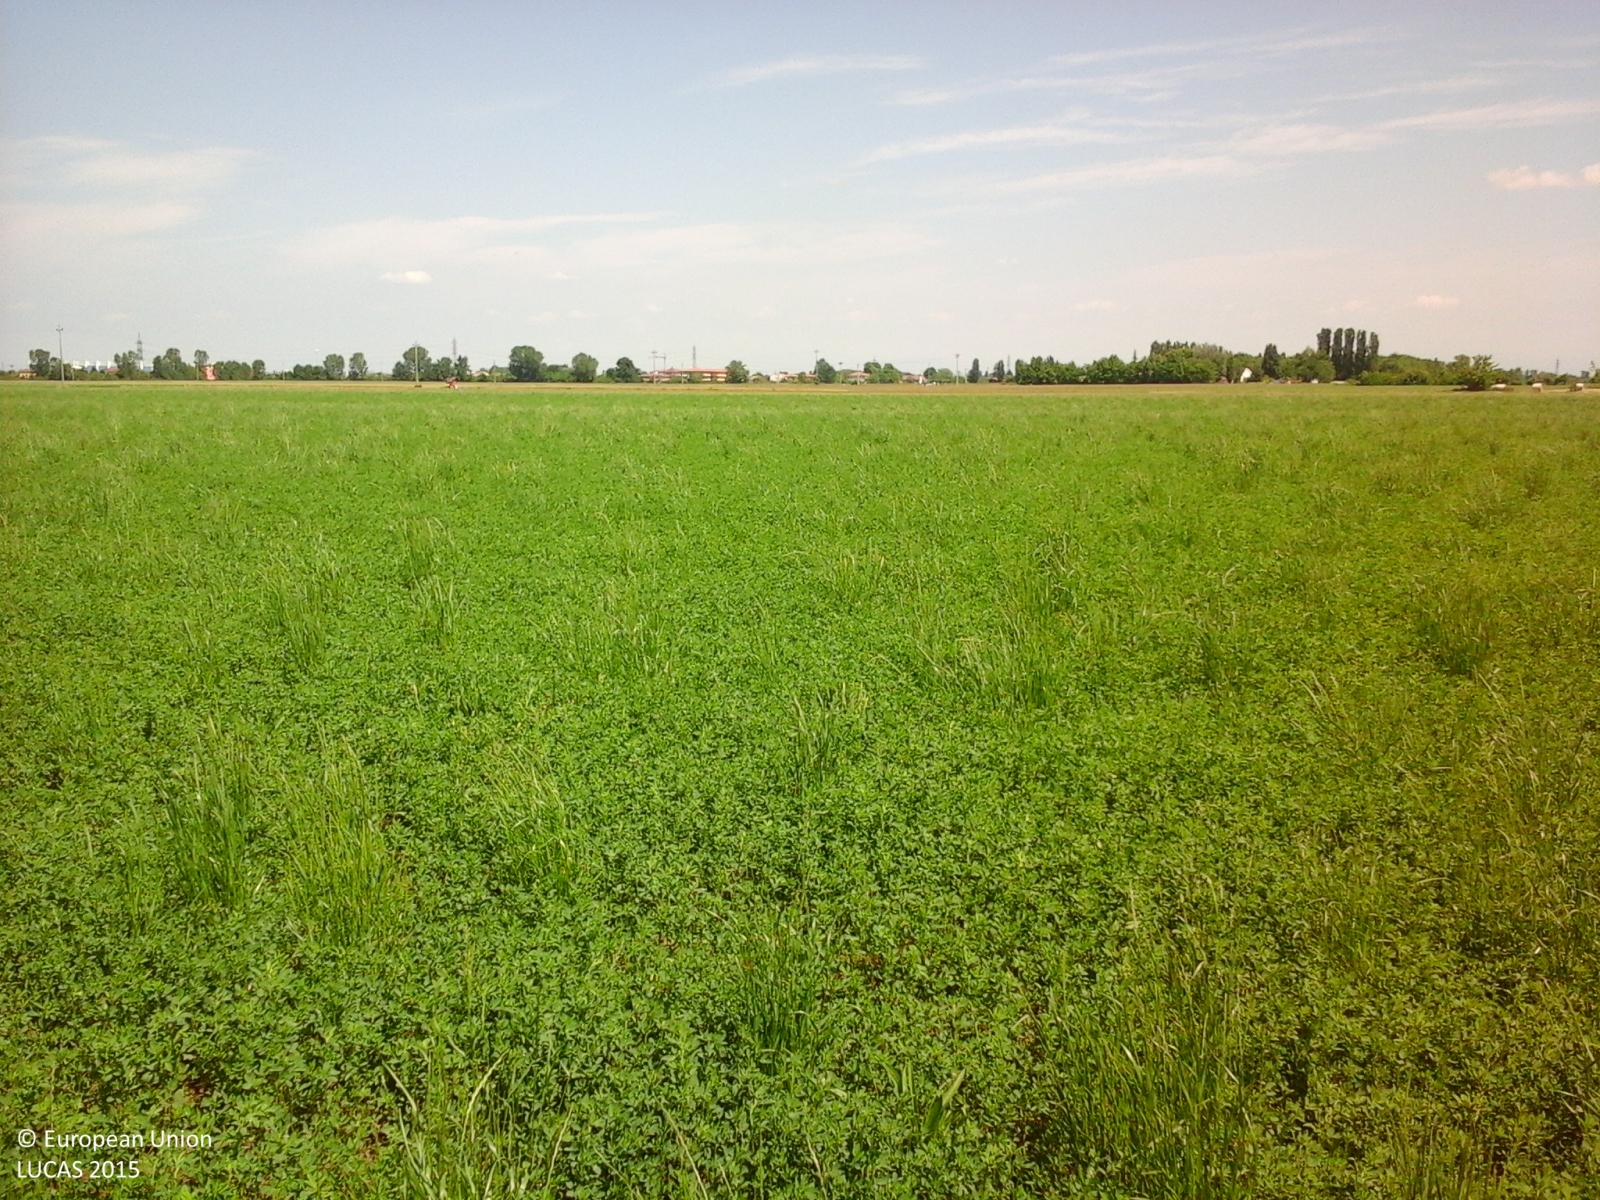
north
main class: Cropland
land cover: Lucerne
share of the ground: > 75 %
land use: Agriculture (excluding fallow land and kitchen gardens)
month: May
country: IT
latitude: 45.1403
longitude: 10.8758
